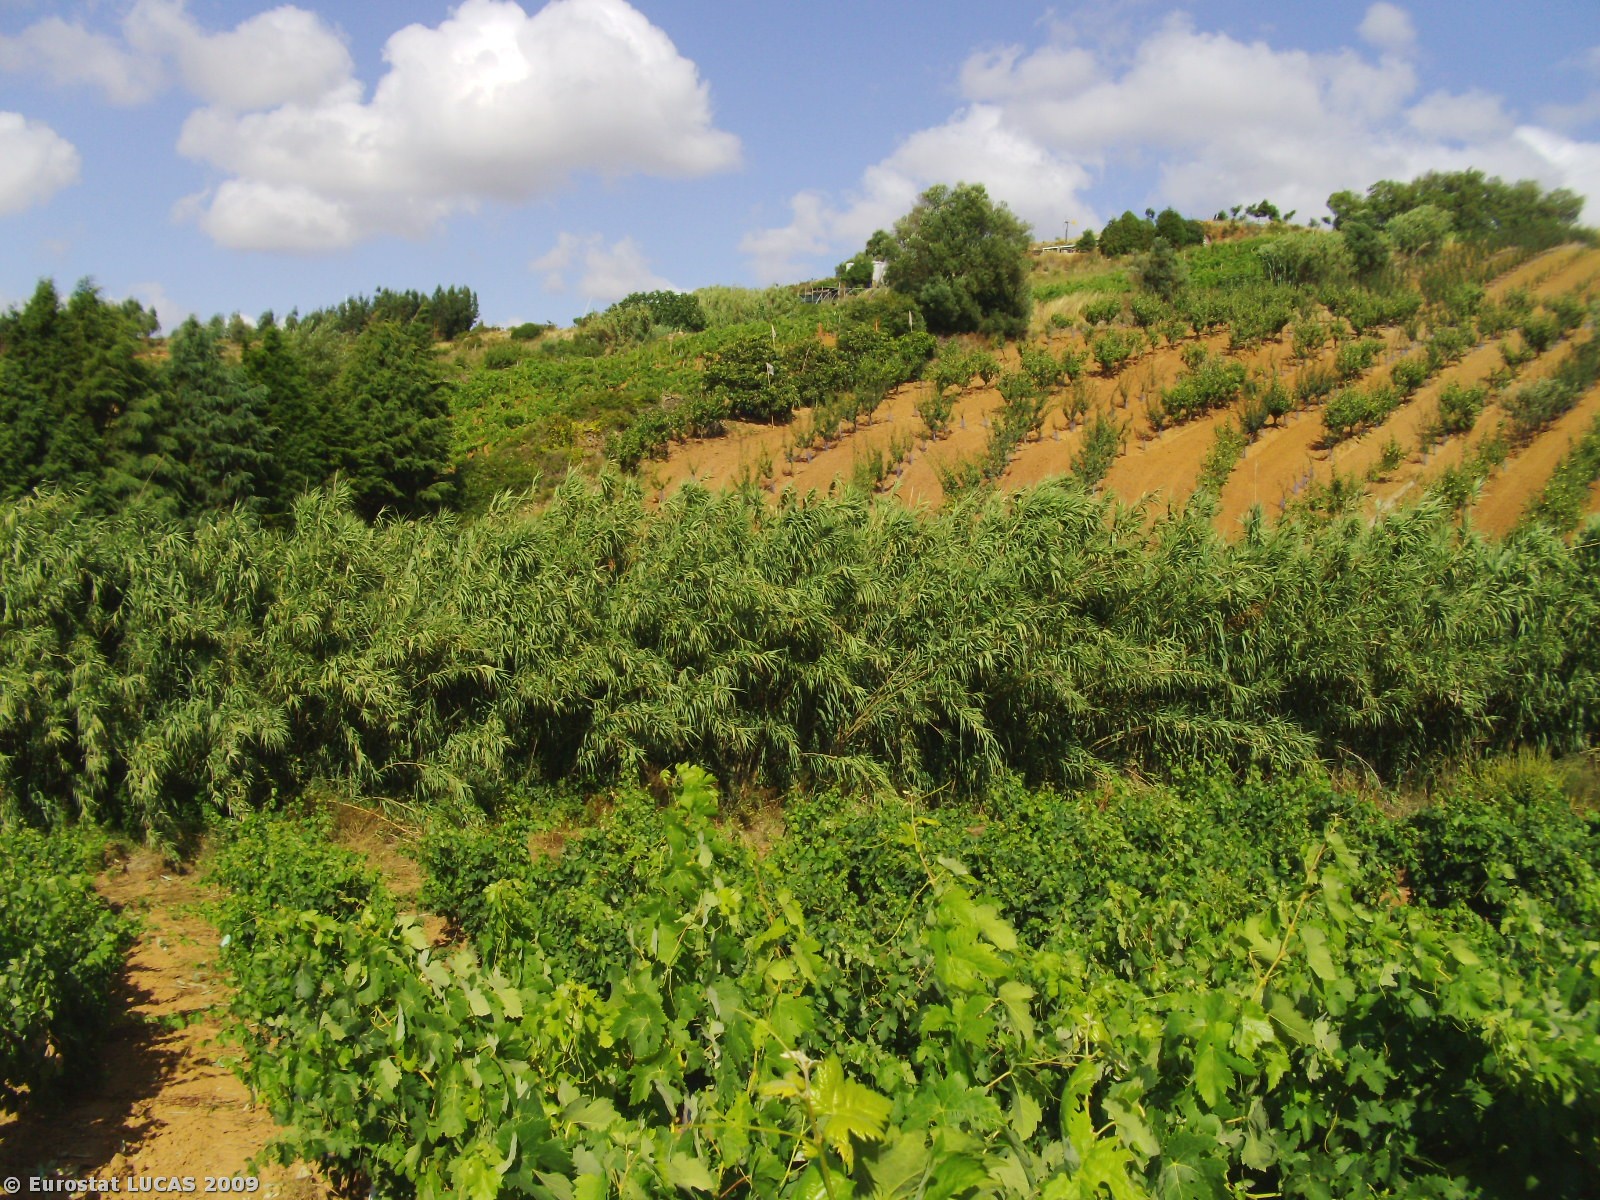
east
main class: Cropland
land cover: Vineyards
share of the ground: 50 - 75 %
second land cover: Bare land
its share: 25 - 50 %
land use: Agriculture (excluding fallow land and kitchen gardens)
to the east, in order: Vineyards; Bare land; Vineyards; Shrubland without tree cover; Pear fruit; Other fruit trees and berries; Single bushes/trees; Shruby margins; Vineyards; Bare land; Artificial constructions in urban areas; Tracks; Grass margins; Apple fruit
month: July
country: PT
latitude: 39.0444
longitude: -9.2531
